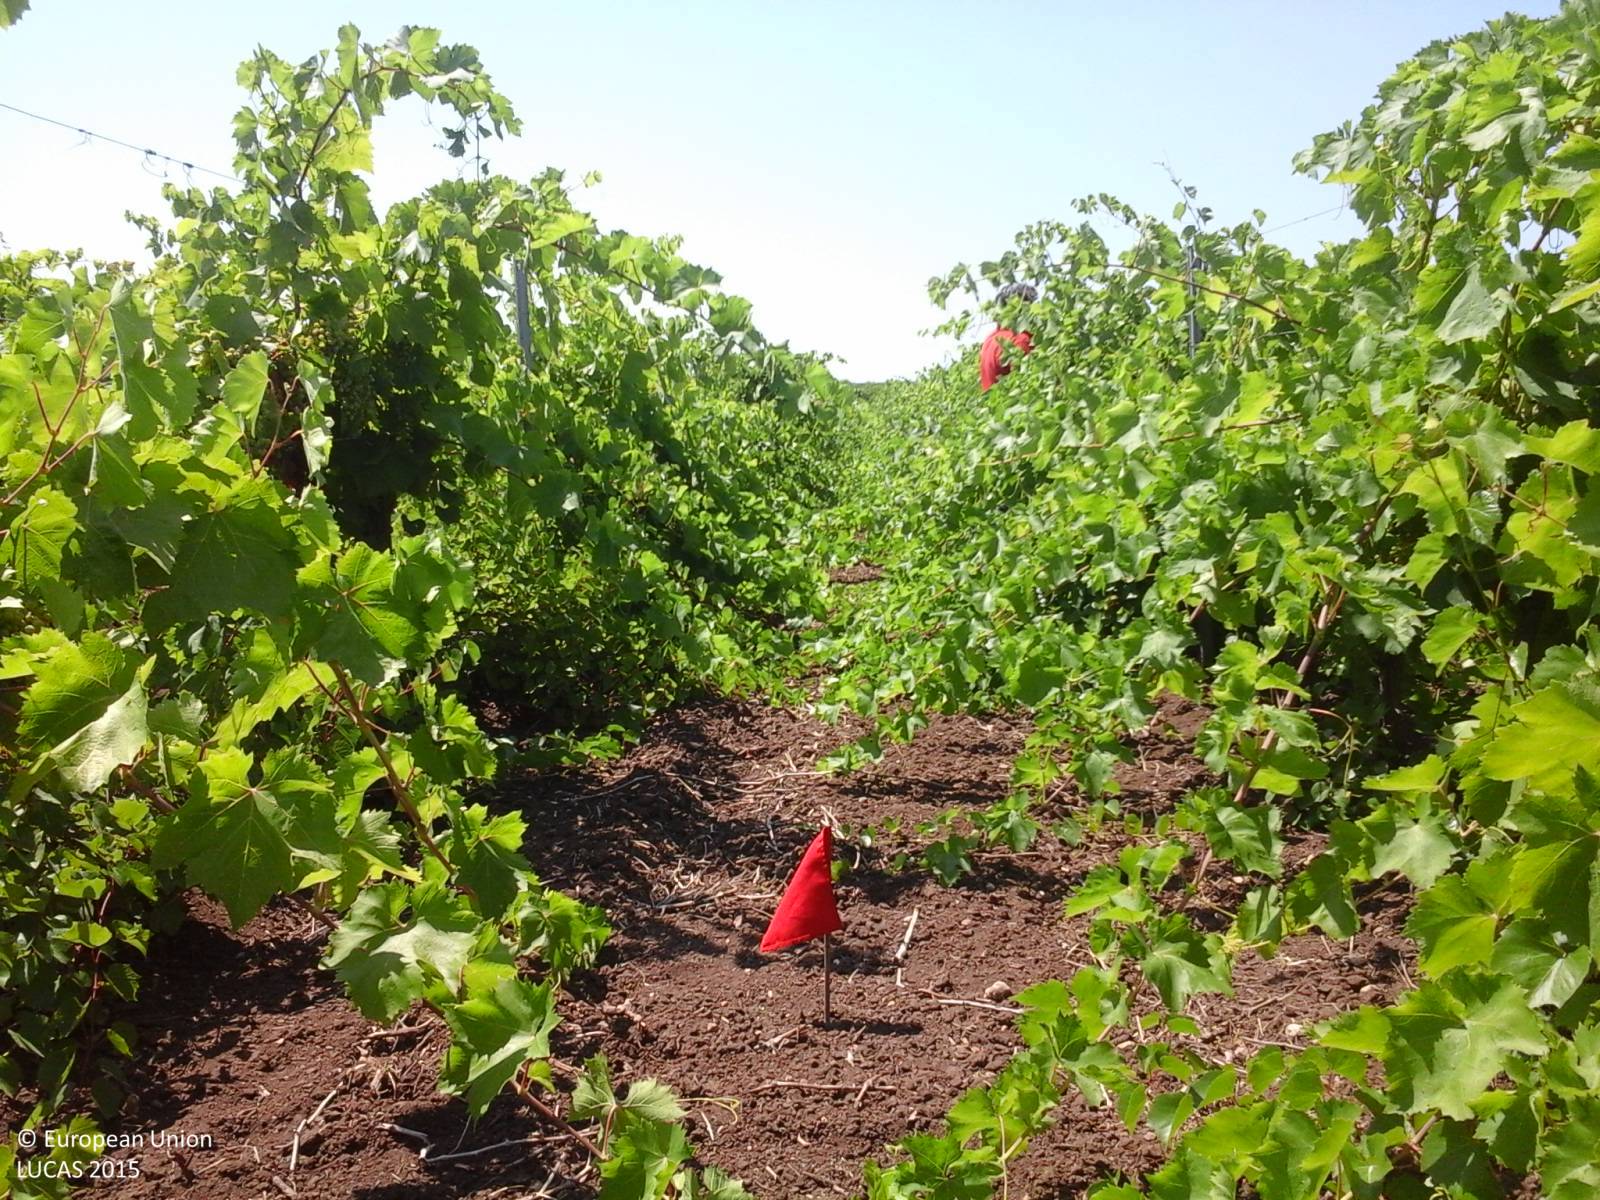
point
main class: Cropland
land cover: Vineyards
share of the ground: 50 - 75 %
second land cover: Other bare soil
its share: > 75 %
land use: Agriculture (excluding fallow land and kitchen gardens)
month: July
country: IT
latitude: 37.7289
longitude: 12.6464
